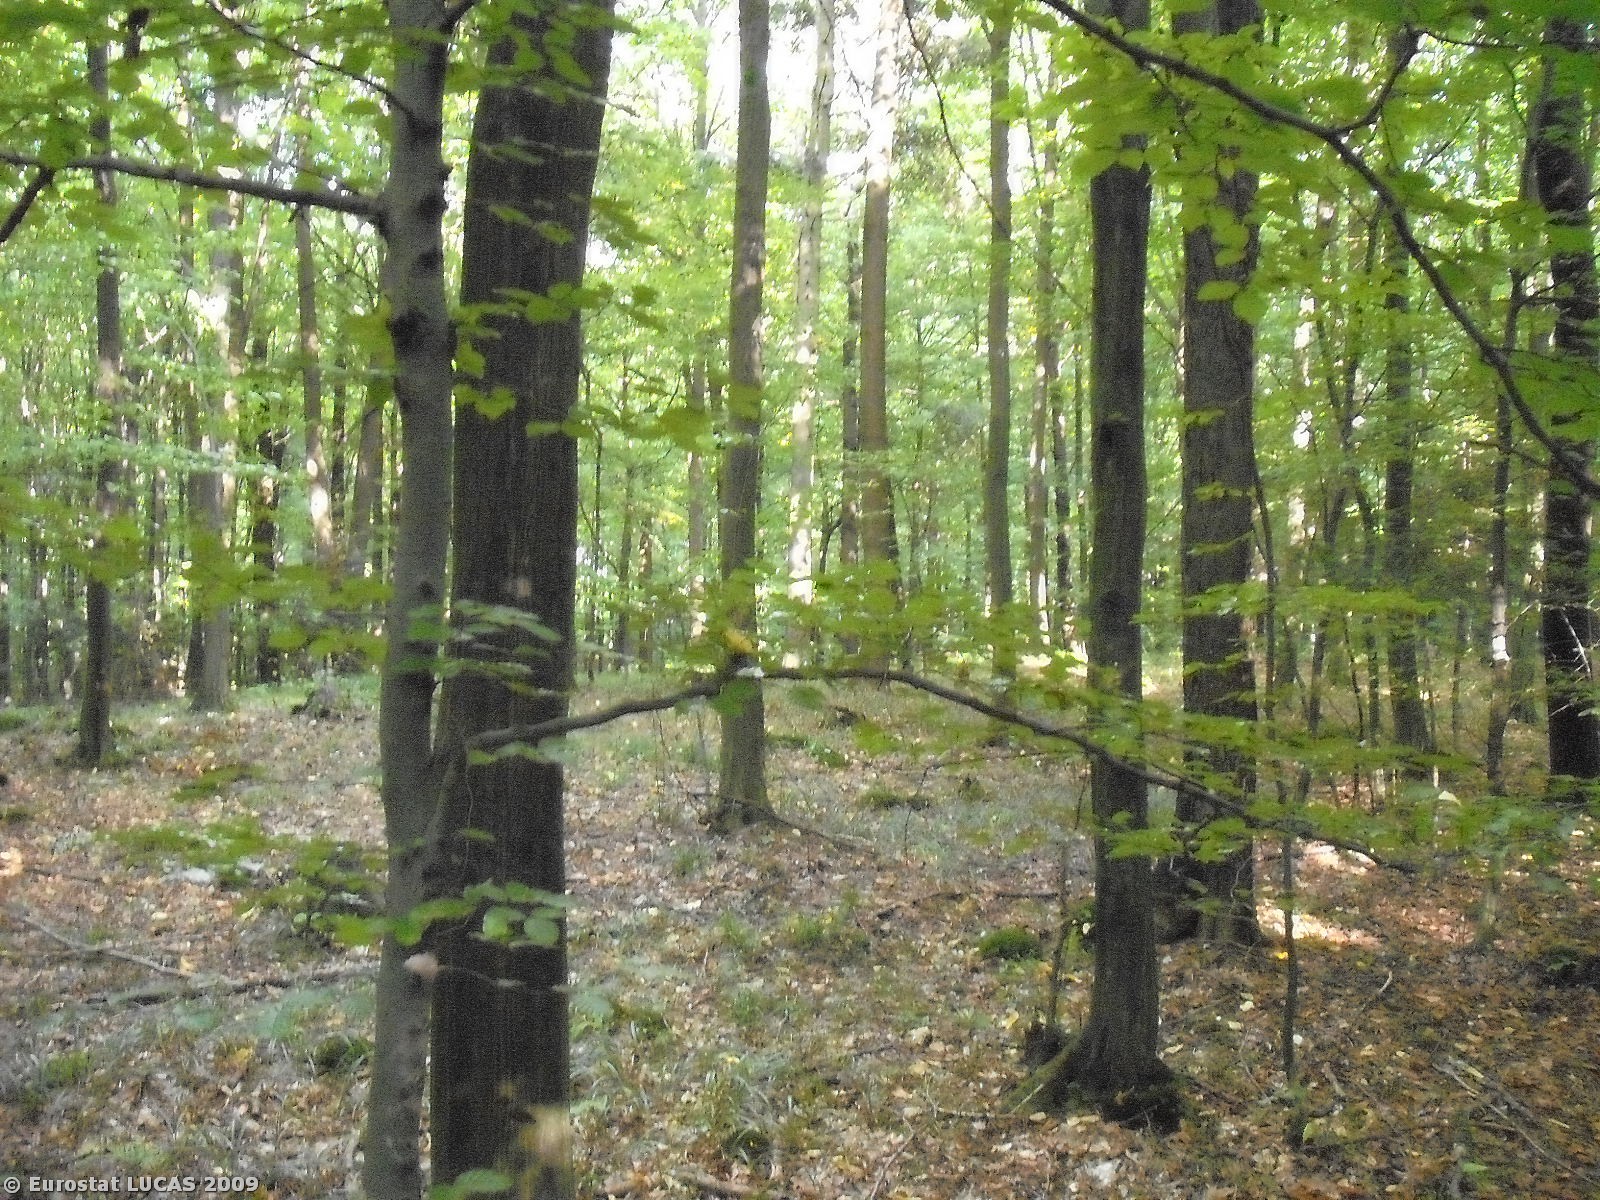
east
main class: Woodland
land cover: Broadleaved woodland
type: mesophytic deciduous forest
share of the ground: > 75 %
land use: Forestry
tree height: > 5 m
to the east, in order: Broadleaved woodland; Grassland with sparse tree/shrub cover; Grassland without tree/shrub cover
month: September
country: PL
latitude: 49.9241
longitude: 22.0510
